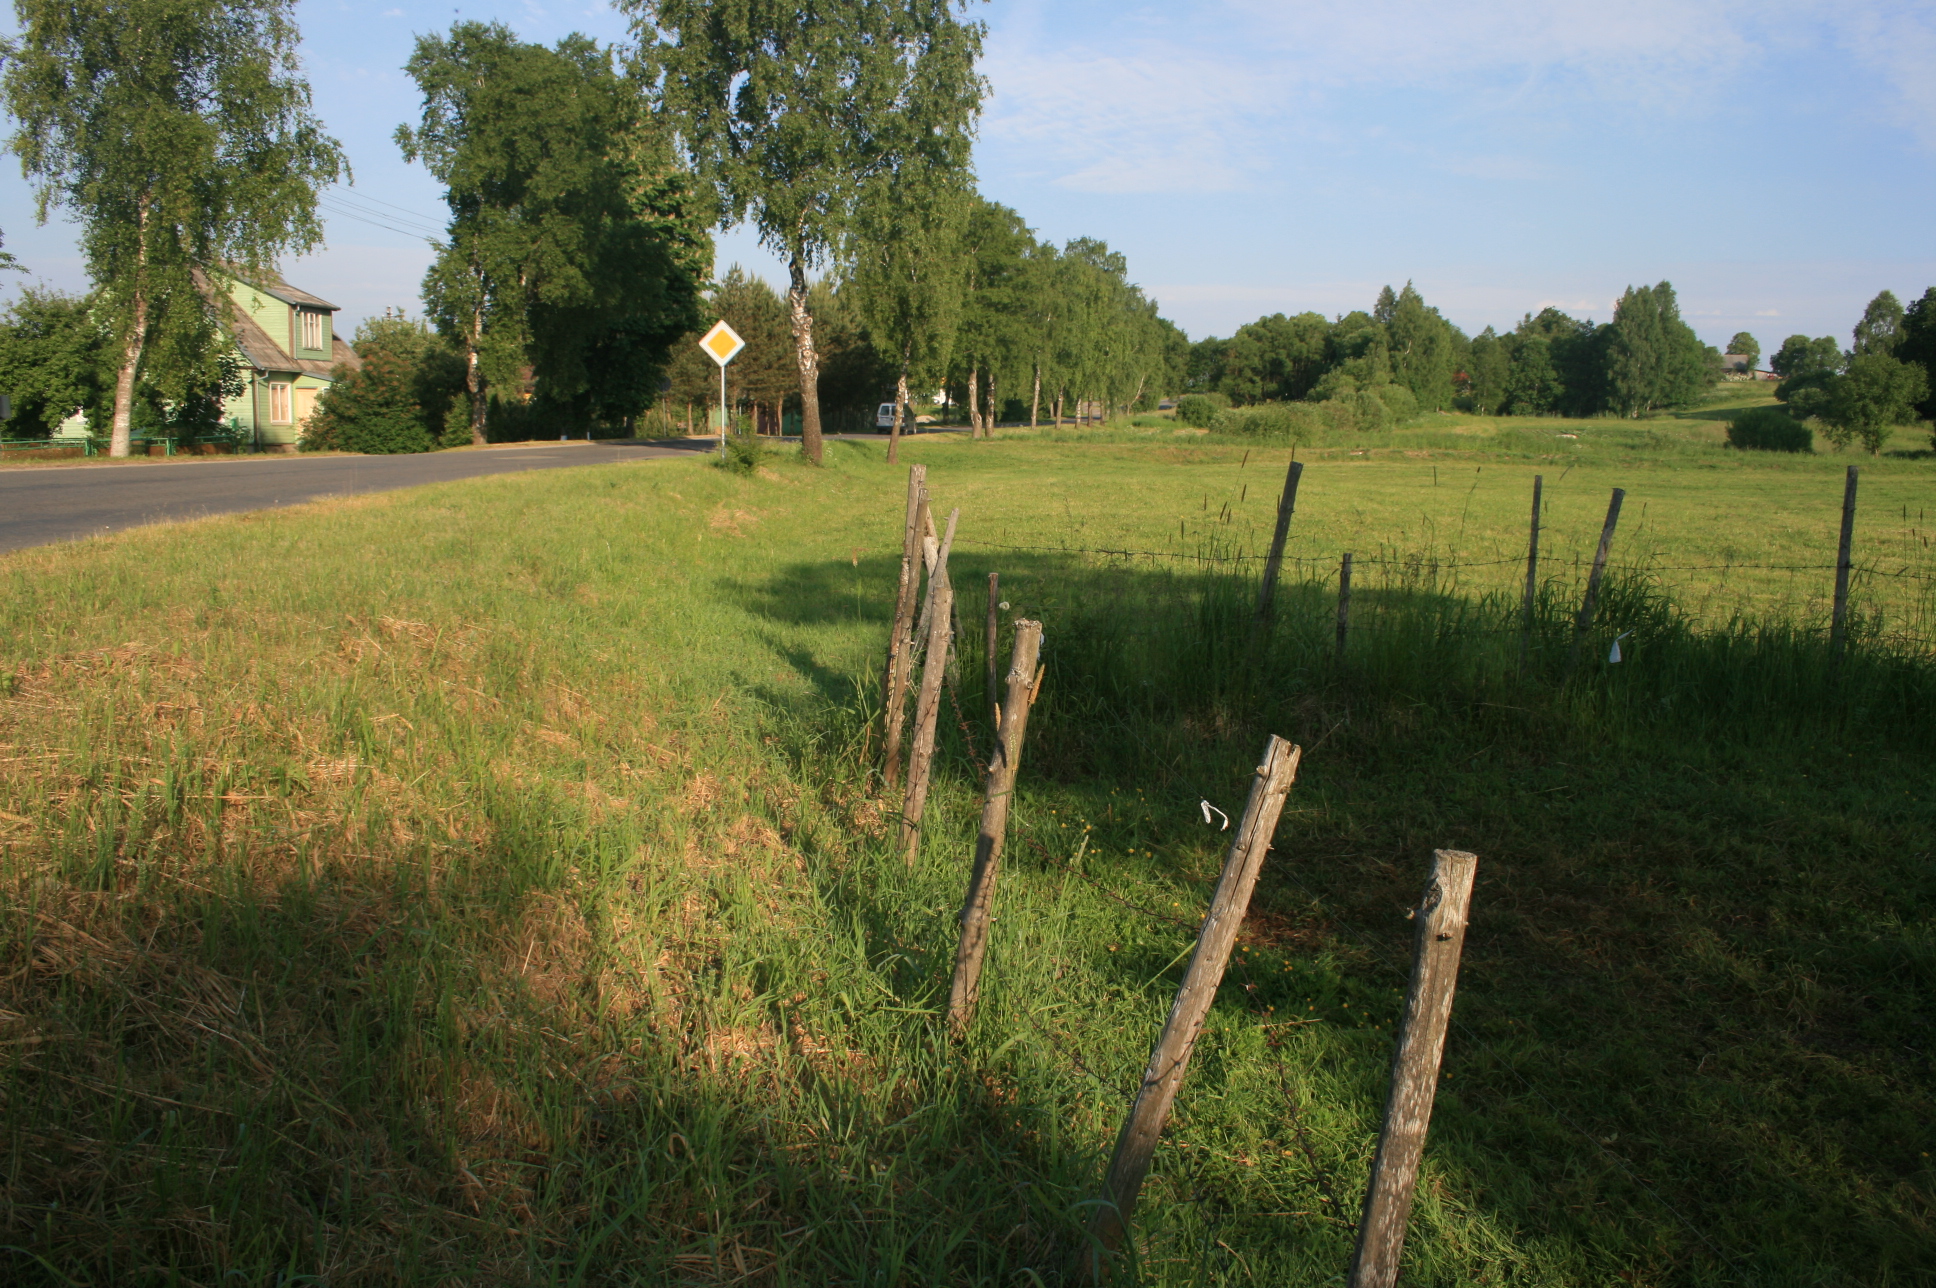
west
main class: Grassland
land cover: Grassland without tree/shrub cover
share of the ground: > 75 %
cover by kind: herbaceous plants 100 %
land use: Agriculture (excluding fallow land and kitchen gardens)
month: June
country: LT
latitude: 55.7360
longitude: 22.1424
